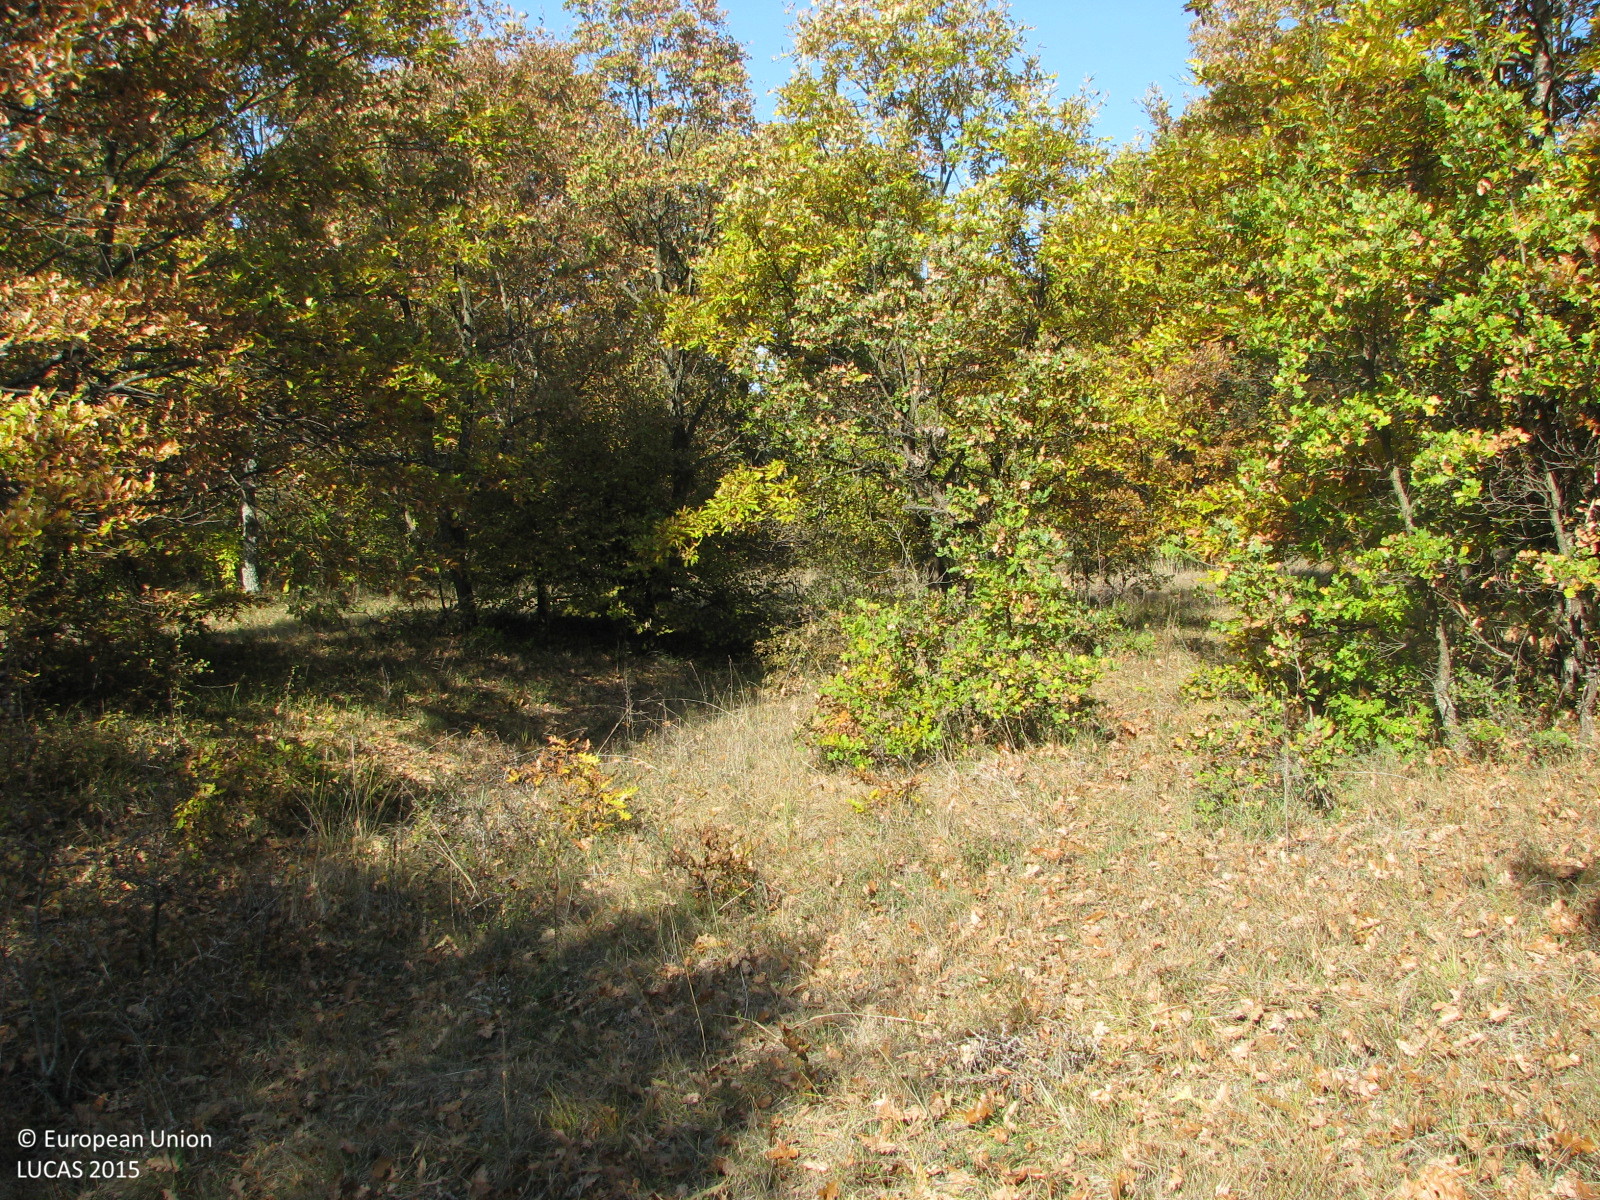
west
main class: Woodland
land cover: Broadleaved woodland
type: thermophilous deciduous forest
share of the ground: 50 - 75 %
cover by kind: broadleaved forest trees 60 %, herbaceous plants 30 %, shrubs 10 %
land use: Semi-natural and natural areas not in use
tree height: > 5 m
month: November
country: BG
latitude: 42.0955
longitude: 26.7419
